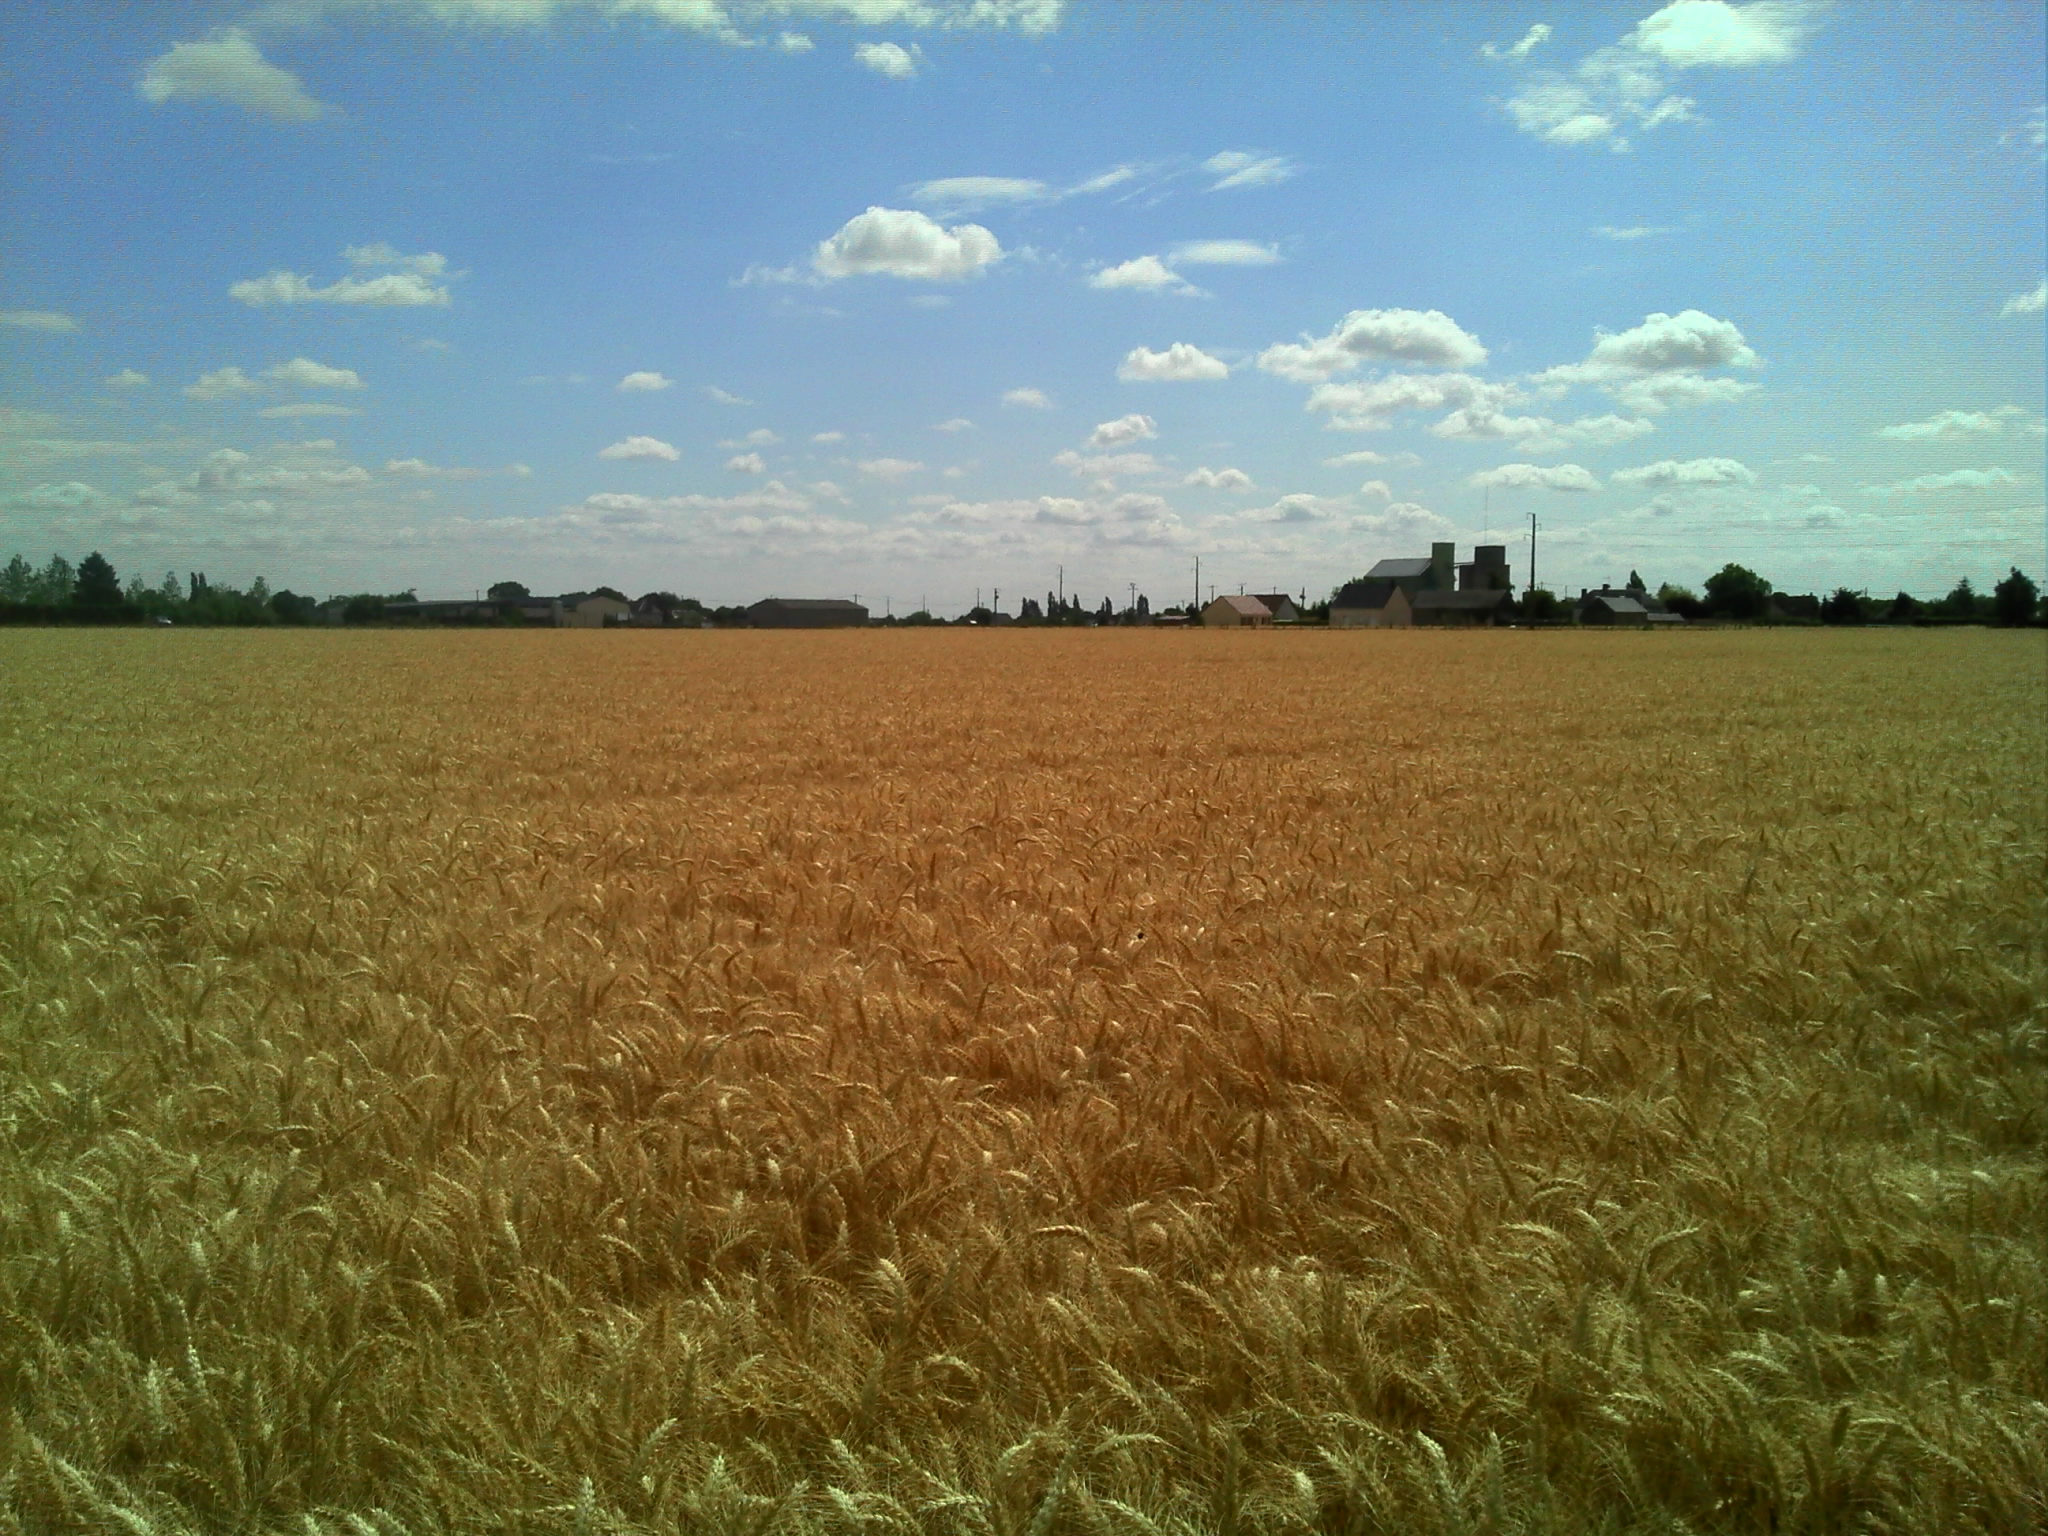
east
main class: Cropland
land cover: Common wheat
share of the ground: > 75 %
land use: Agriculture (excluding fallow land and kitchen gardens)
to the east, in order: Common wheat; Grass margins; Fences; Grassland without tree/shrub cover
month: July
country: FR
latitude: 48.8790
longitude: 1.1300
